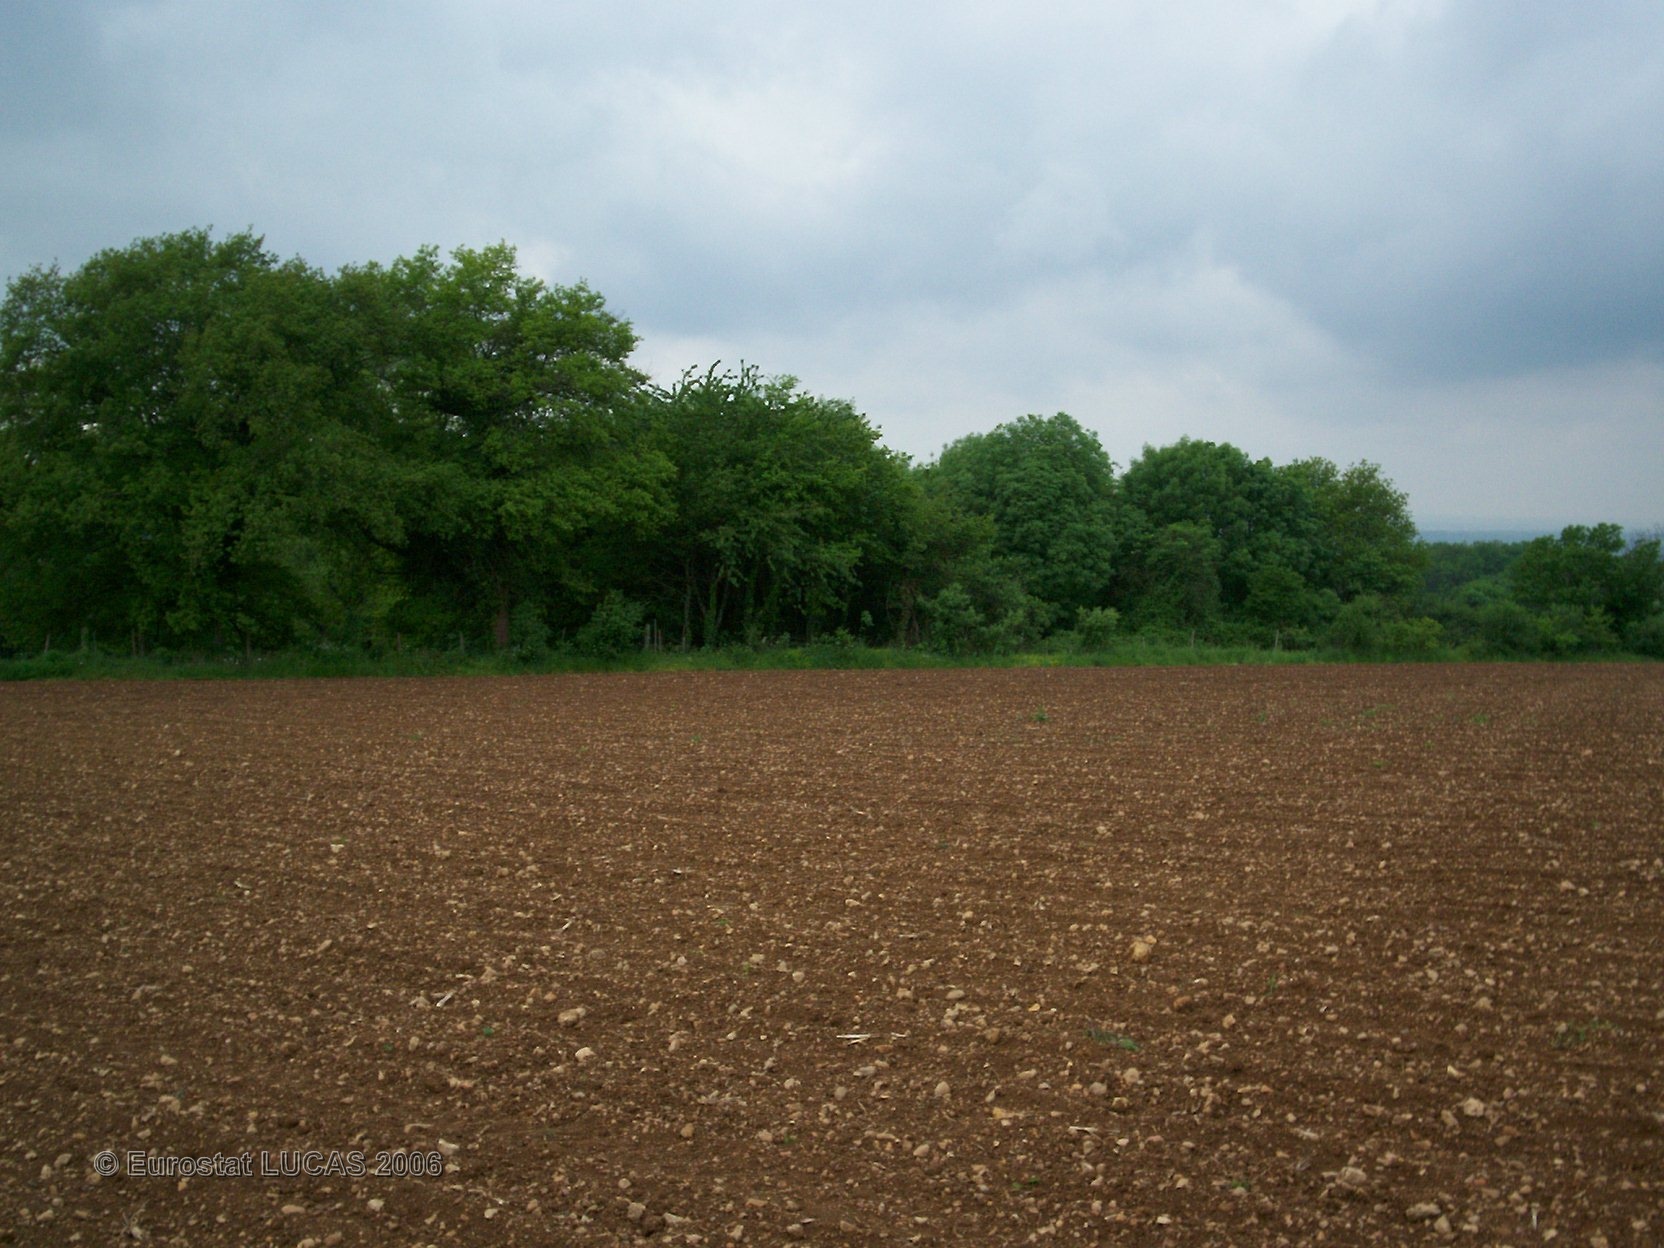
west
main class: Cropland
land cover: Maize
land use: Agriculture (excluding fallow land and kitchen gardens)
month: May
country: FR
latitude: 45.7272
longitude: 0.4902
